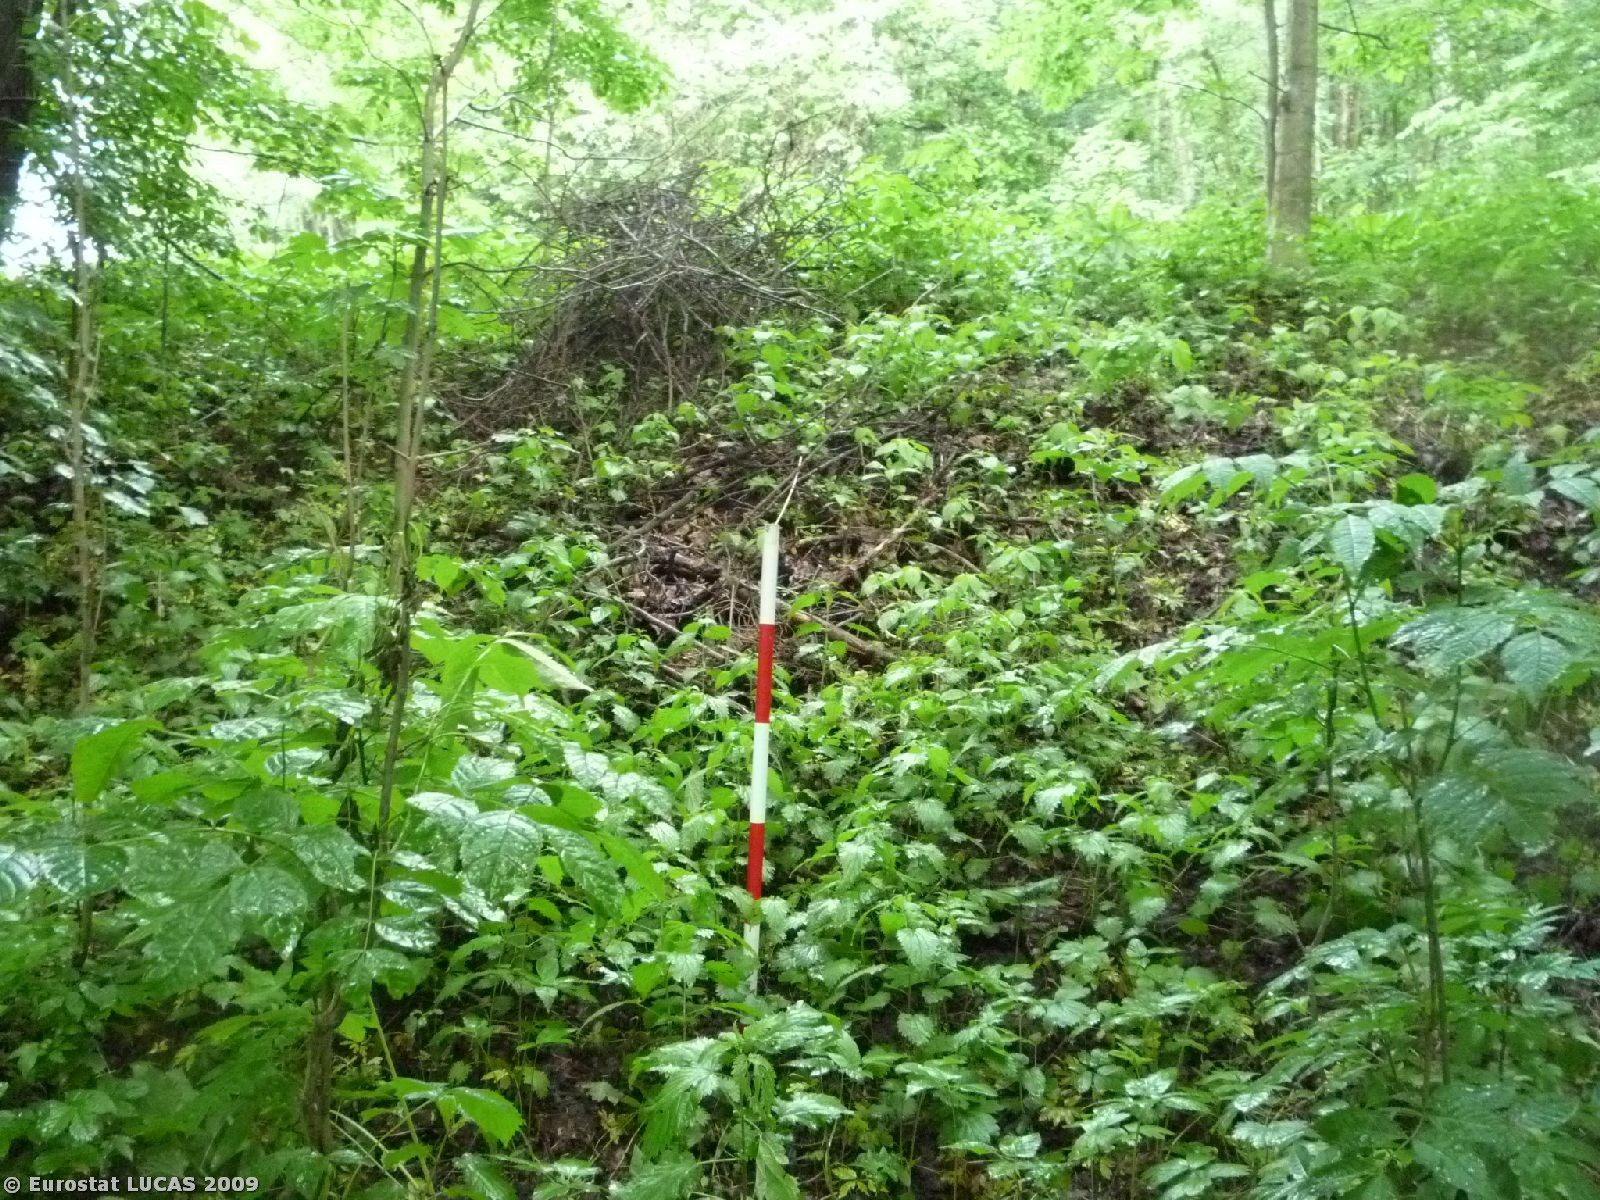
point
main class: Woodland
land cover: Broadleaved woodland
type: mesophytic deciduous forest
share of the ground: > 75 %
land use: Forestry
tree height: > 5 m
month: June
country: CZ
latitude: 50.6254
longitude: 15.5598
